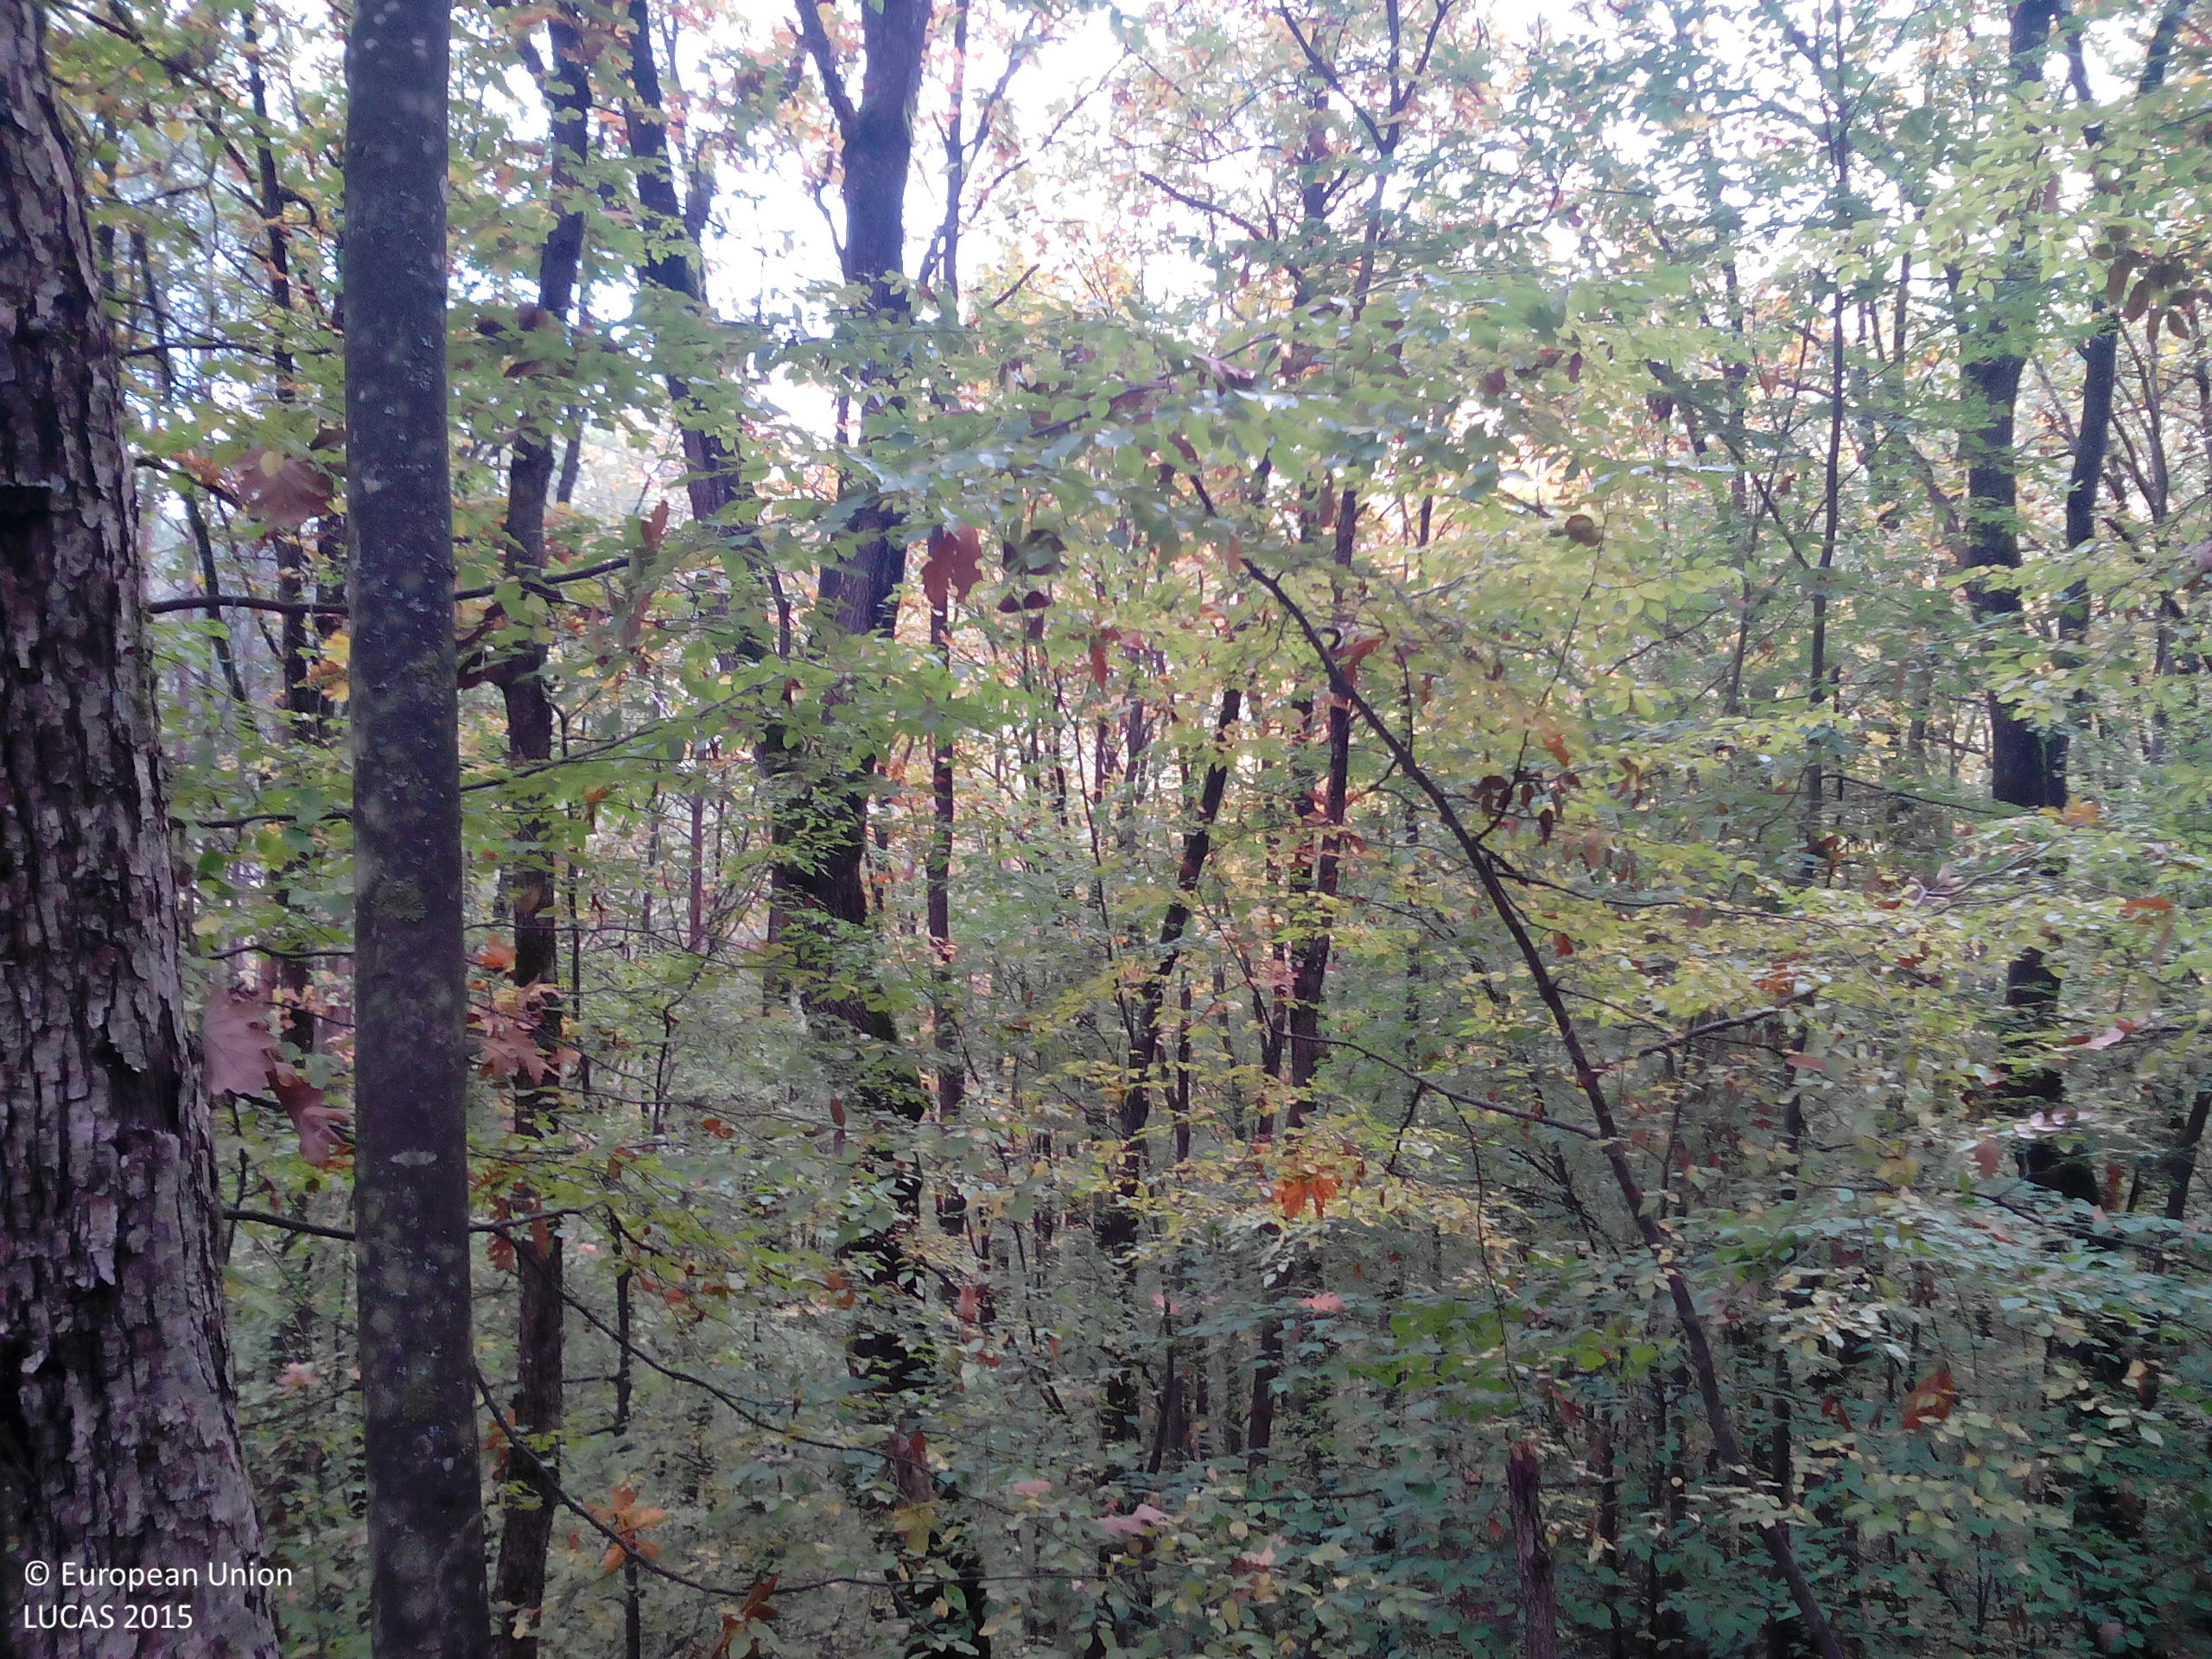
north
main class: Woodland
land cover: Other mixed woodland
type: acidophilous oak and oak-birch forest
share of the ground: > 75 %
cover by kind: broadleaved forest trees 70 %, coniferous forest trees 25 %, shrubs 5 %
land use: Forestry
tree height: > 5 m
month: October
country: BG
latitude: 43.0433
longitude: 23.9056
